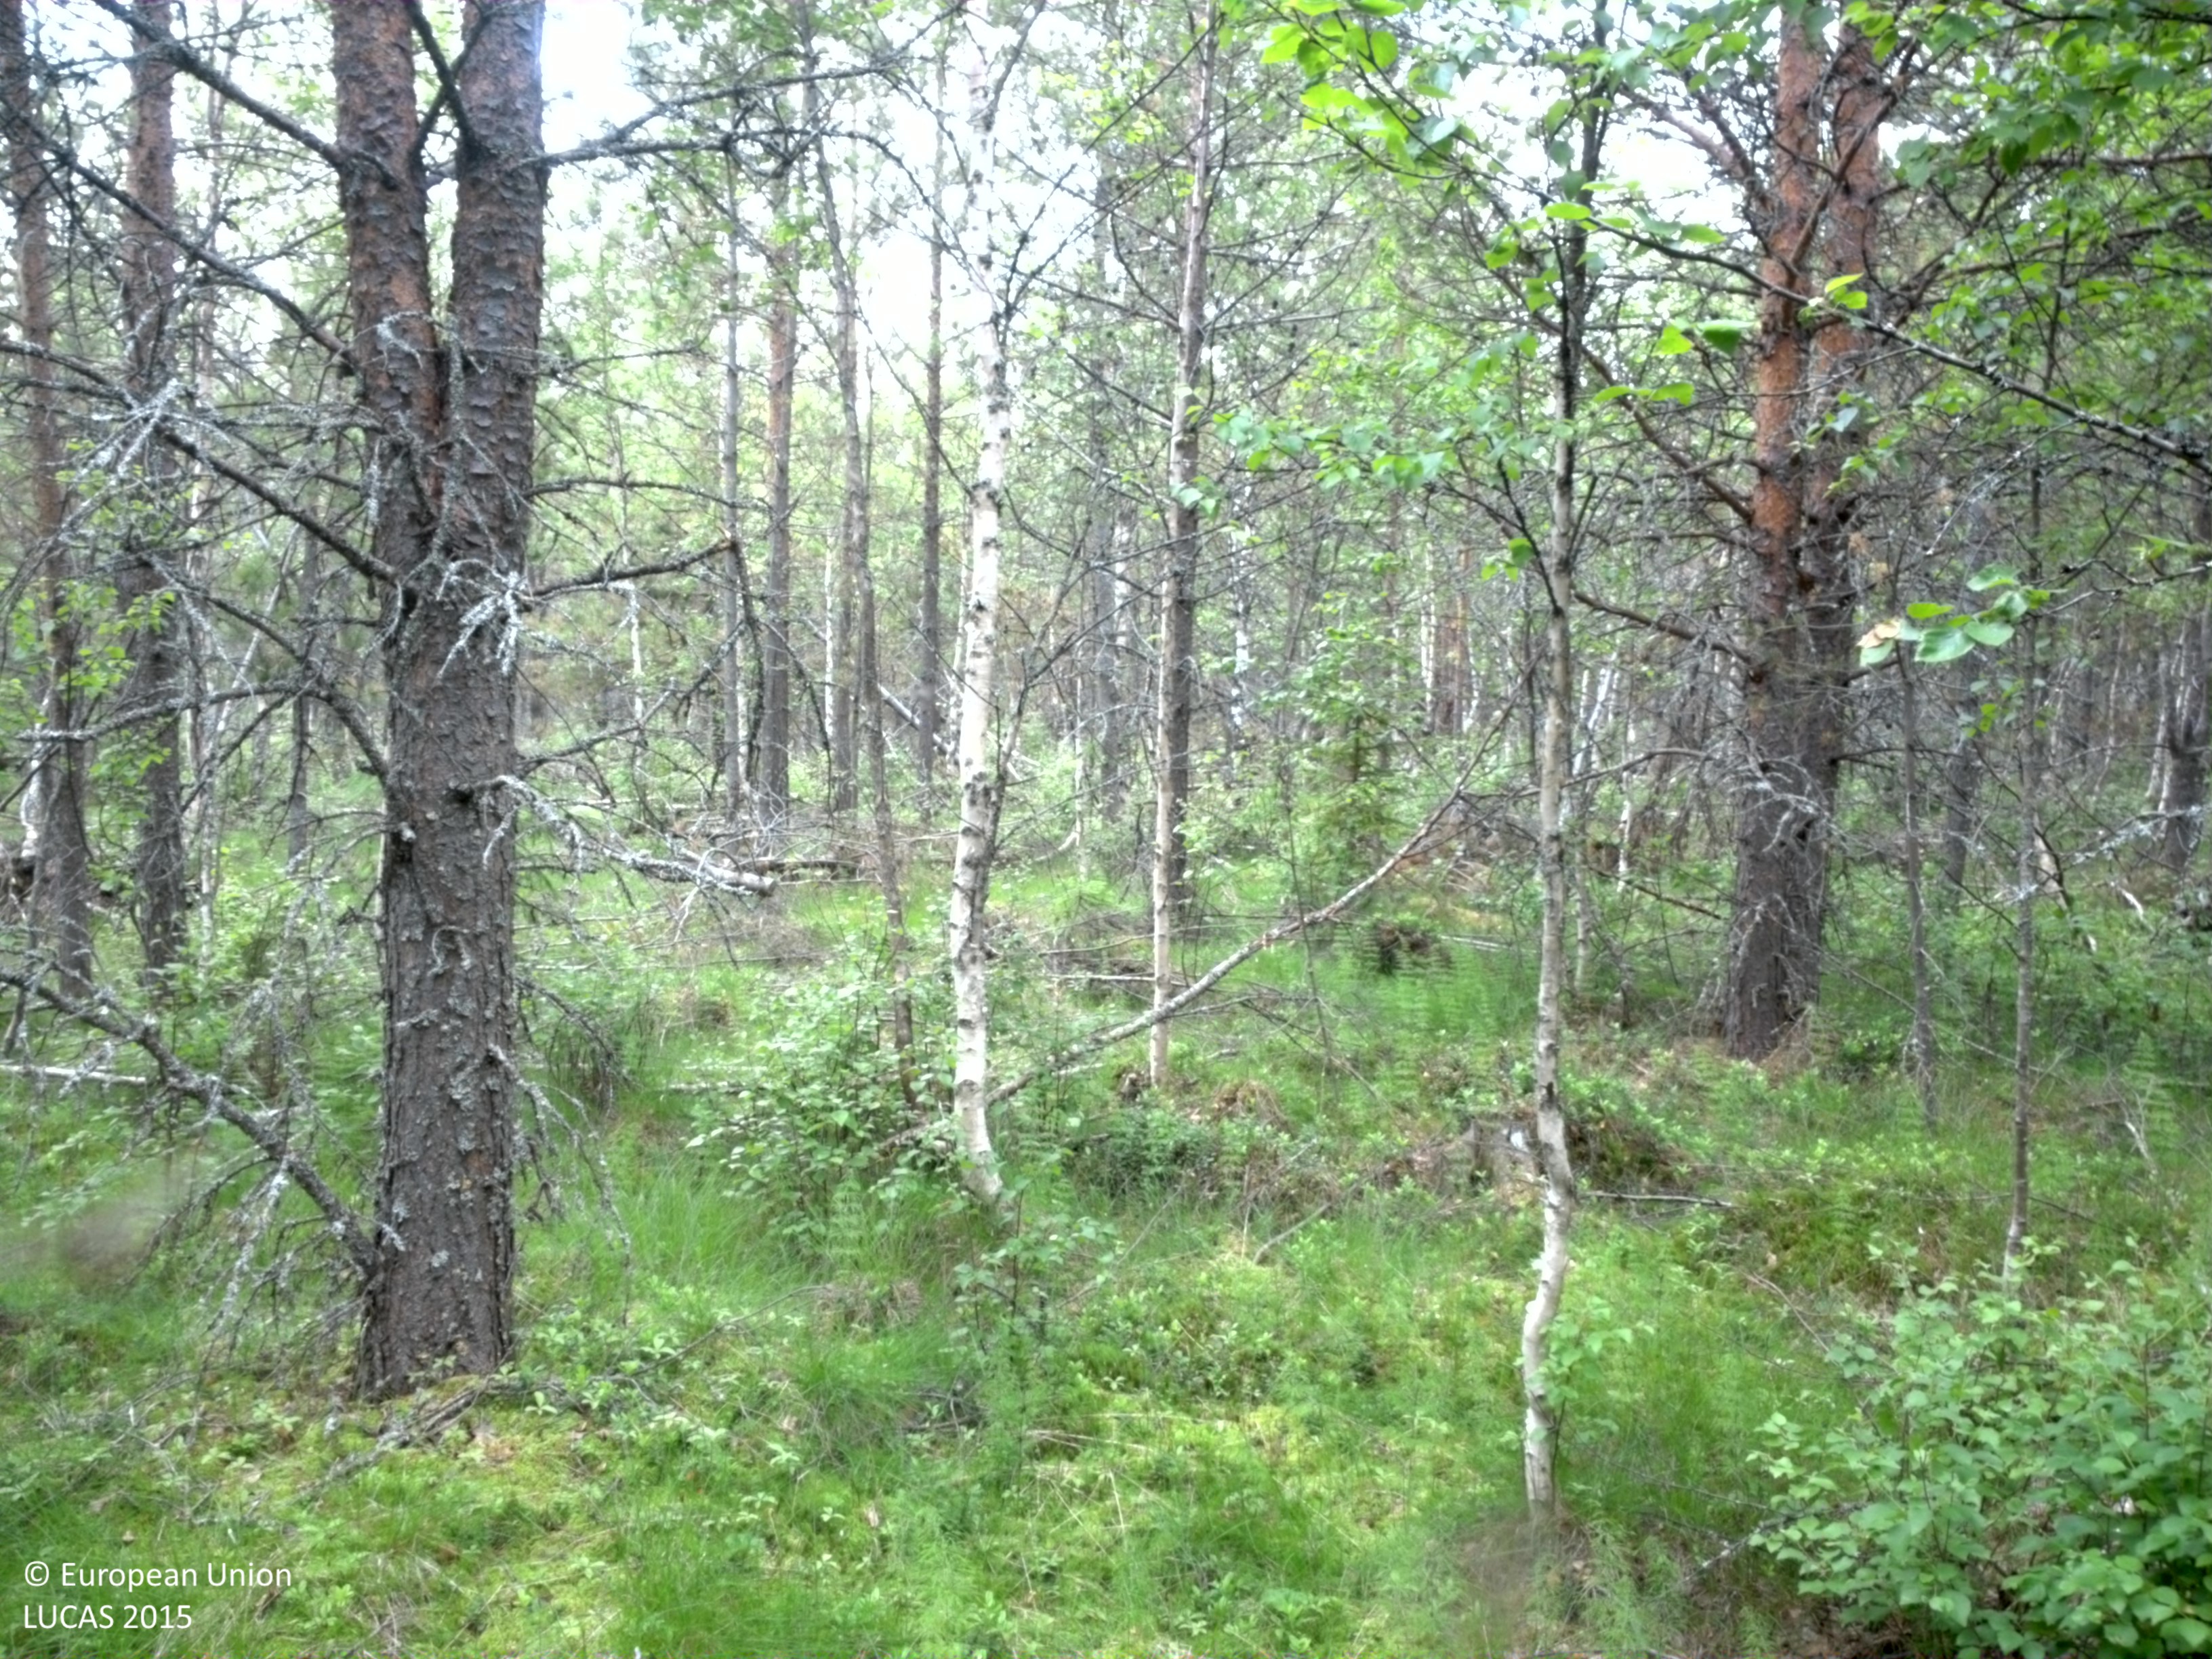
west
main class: Woodland
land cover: Other mixed woodland
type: boreal forest
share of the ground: 50 - 75 %
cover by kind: coniferous forest trees 45 %, broadleaved forest trees 25 %, shrubs 15 %, herbaceous plants 15 %
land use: Forestry
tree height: > 5 m
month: July
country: SE
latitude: 64.4756
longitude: 20.9422
